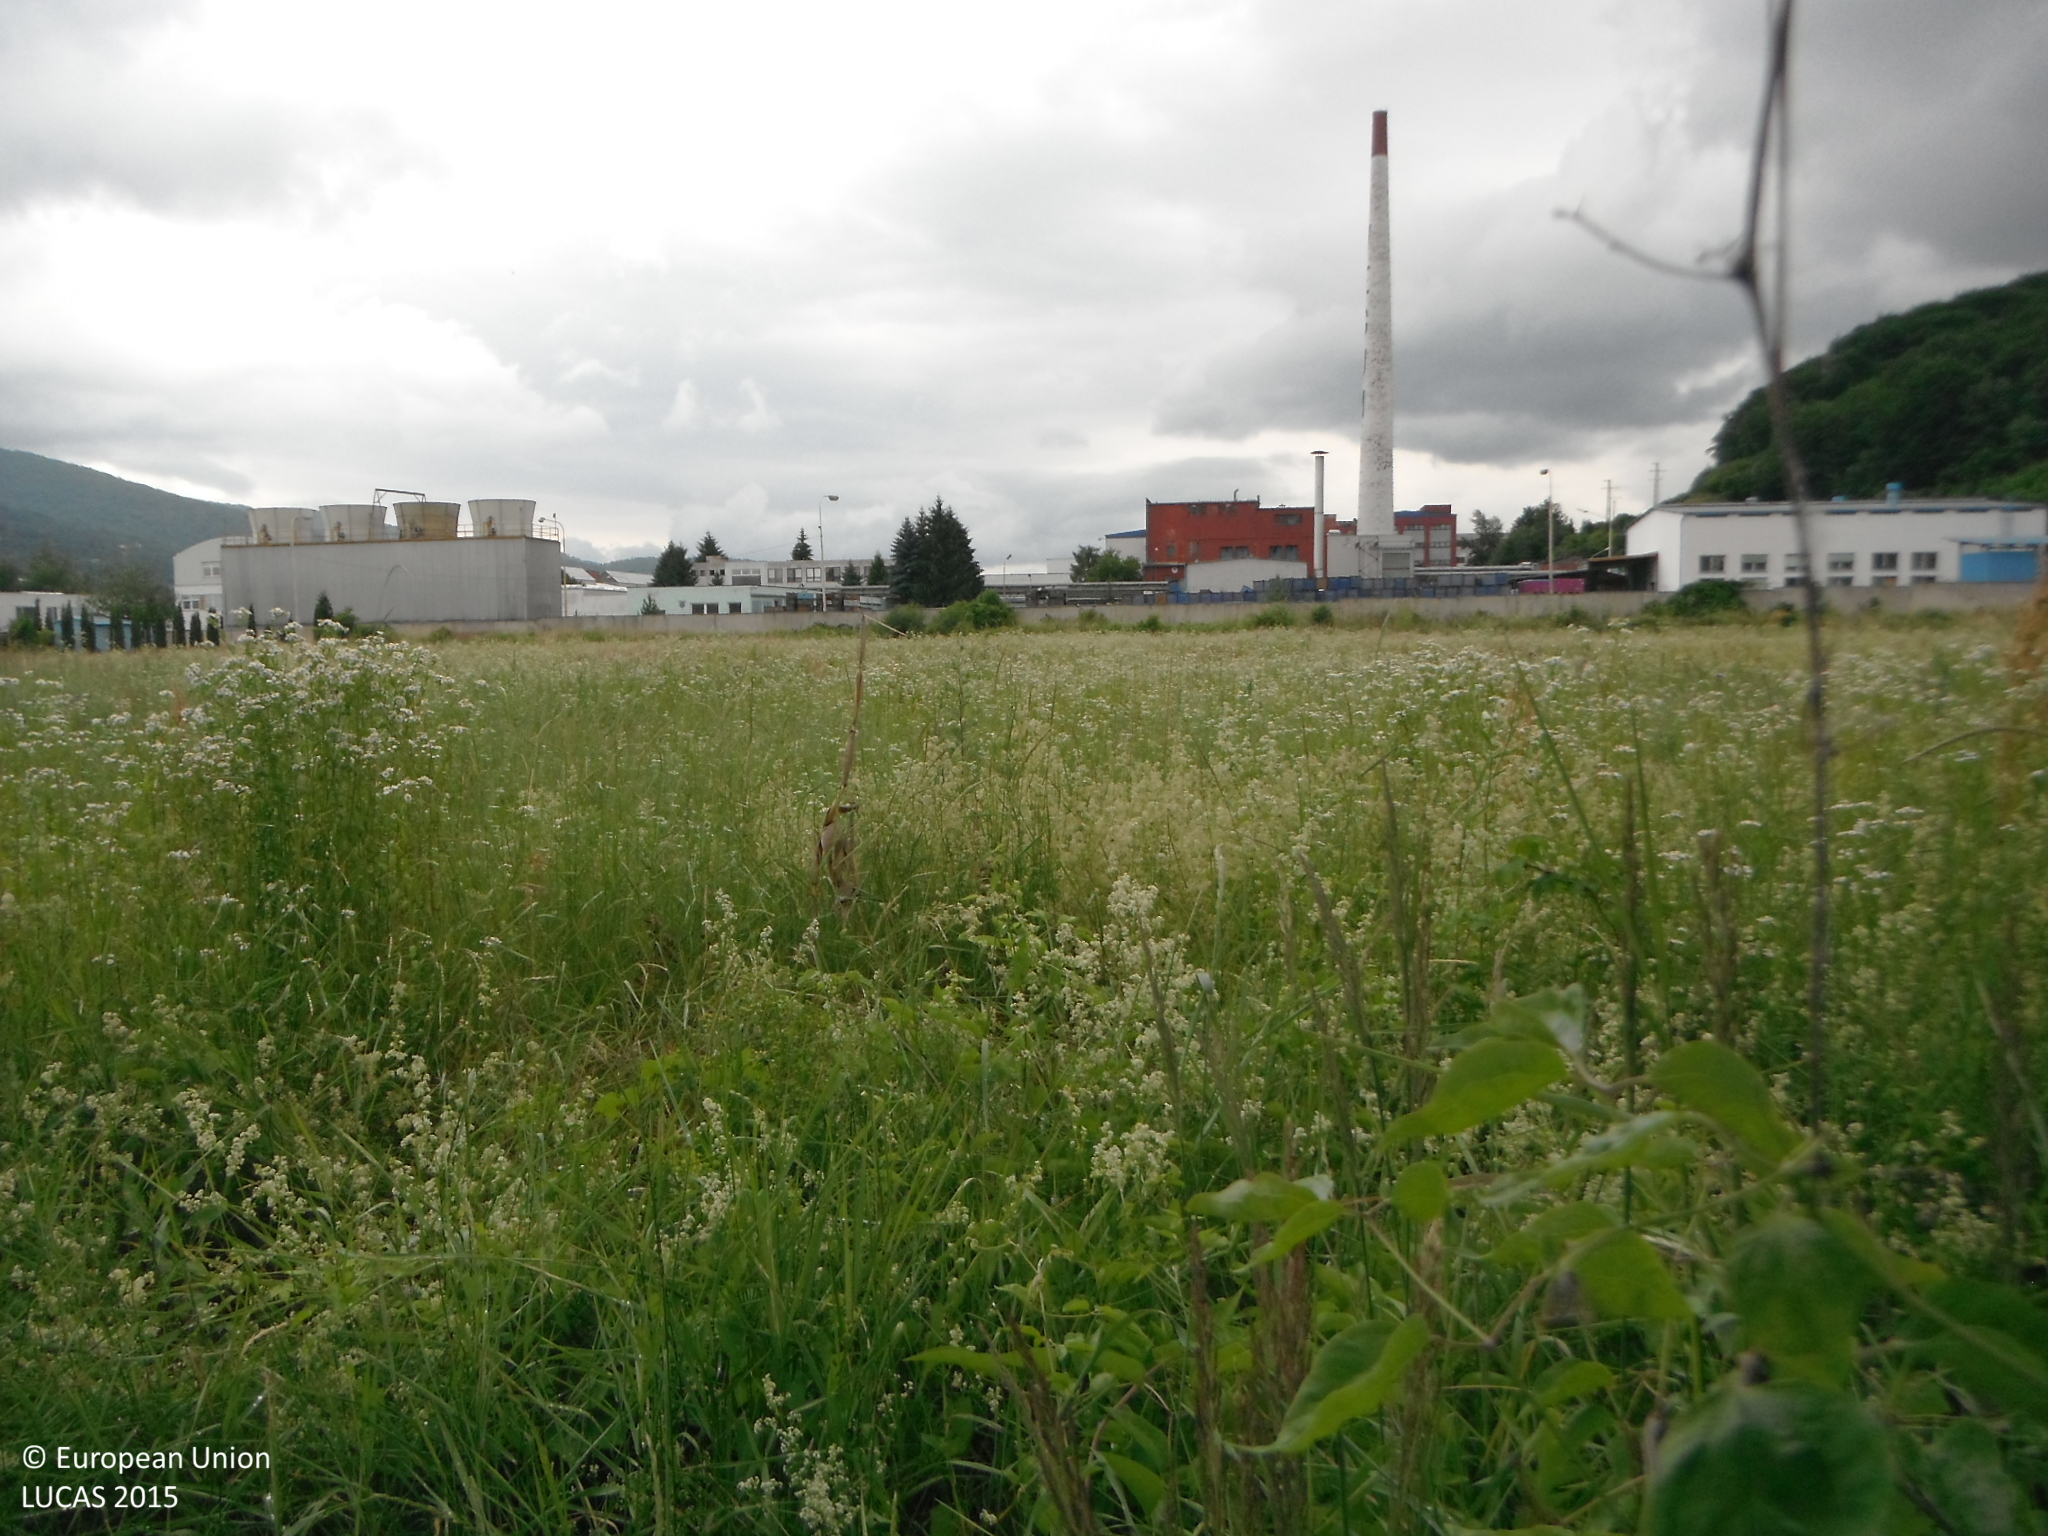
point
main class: Grassland
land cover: Spontaneously vegetated surfaces
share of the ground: > 75 %
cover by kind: herbaceous plants 95 %, shrubs 5 %
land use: Abandoned areas
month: June
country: SK
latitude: 48.6985
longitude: 18.3996
